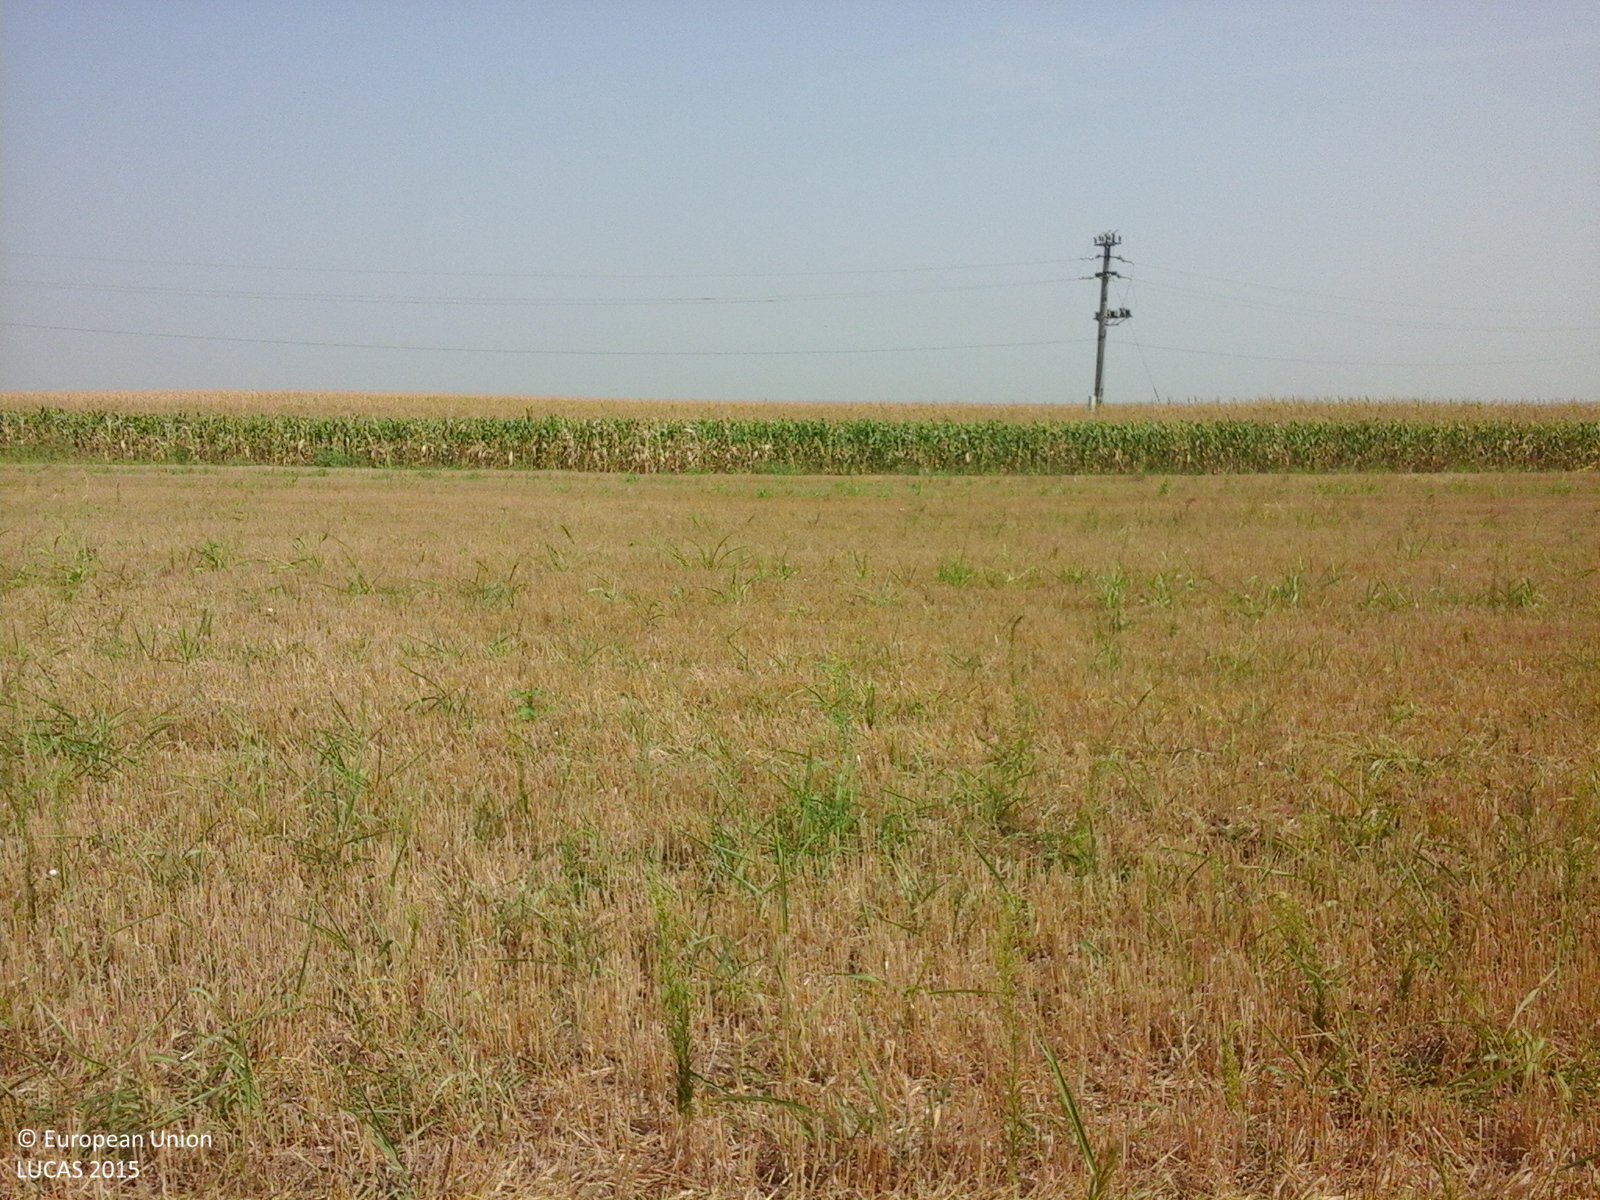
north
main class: Cropland
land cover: Maize
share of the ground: > 75 %
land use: Agriculture (excluding fallow land and kitchen gardens)
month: August
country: RO
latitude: 43.8979
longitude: 23.2533
